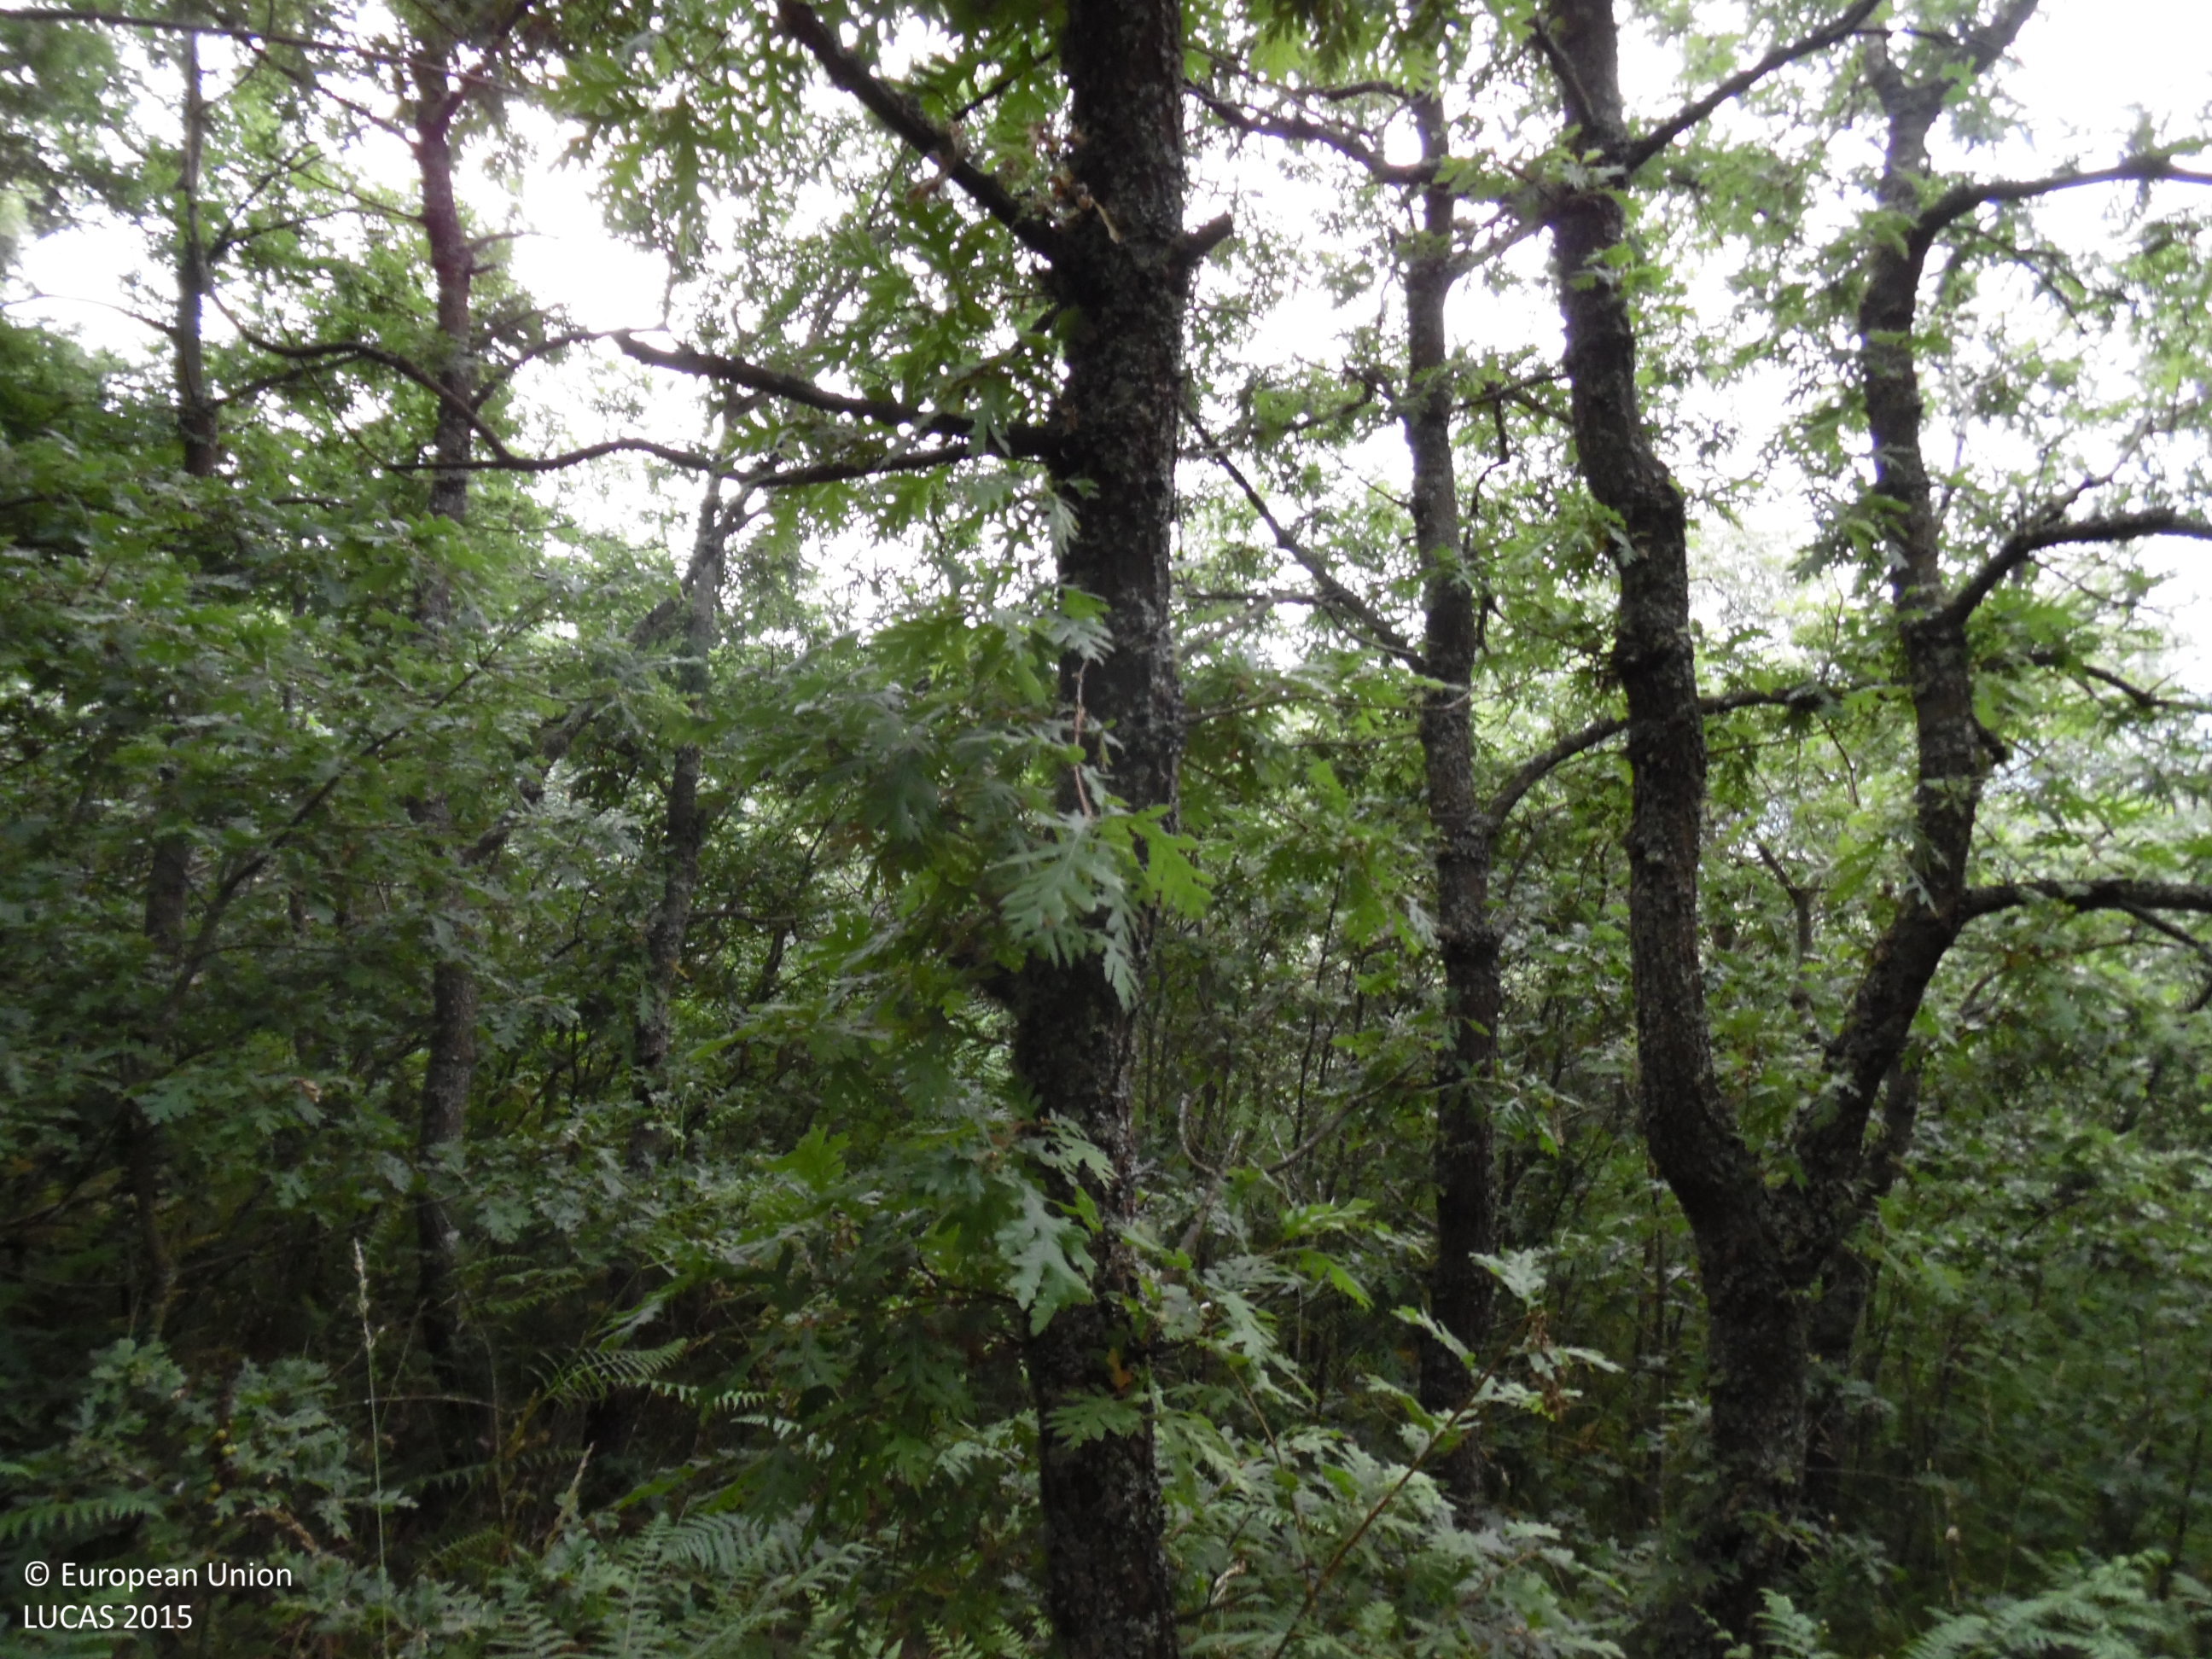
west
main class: Woodland
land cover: Broadleaved woodland
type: thermophilous deciduous forest
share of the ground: > 75 %
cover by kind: broadleaved forest trees 90 %, shrubs 5 %, consolidated bare surface 5 %
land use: Forestry
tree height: > 5 m
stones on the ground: < 10 %
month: July
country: ES
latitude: 43.1895
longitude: -6.5787
